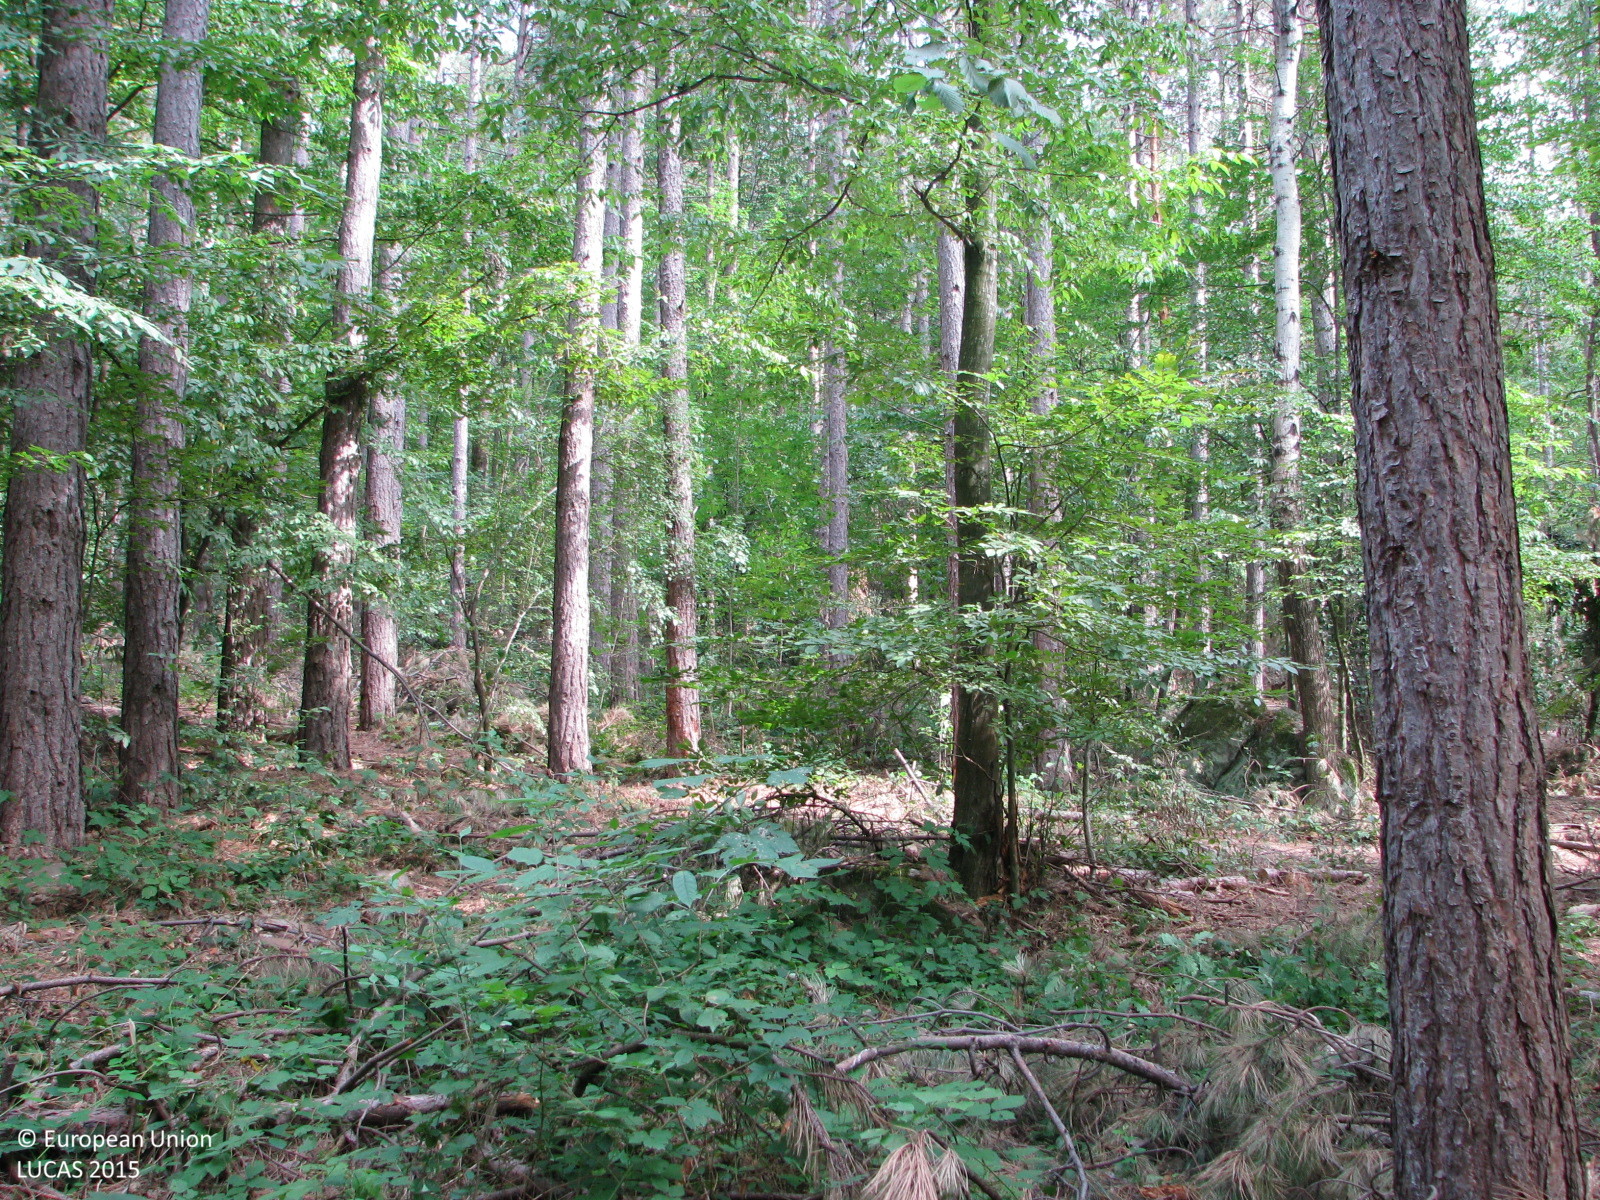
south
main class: Woodland
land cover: Pine dominated mixed woodland
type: coniferous forest of the mediterranean region
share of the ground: > 75 %
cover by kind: coniferous forest trees 45 %, broadleaved forest trees 30 %, consolidated bare surface 15 %, shrubs 5 %, herbaceous plants 5 %
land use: Forestry
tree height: > 5 m
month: August
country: BG
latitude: 42.8538
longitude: 26.1569
